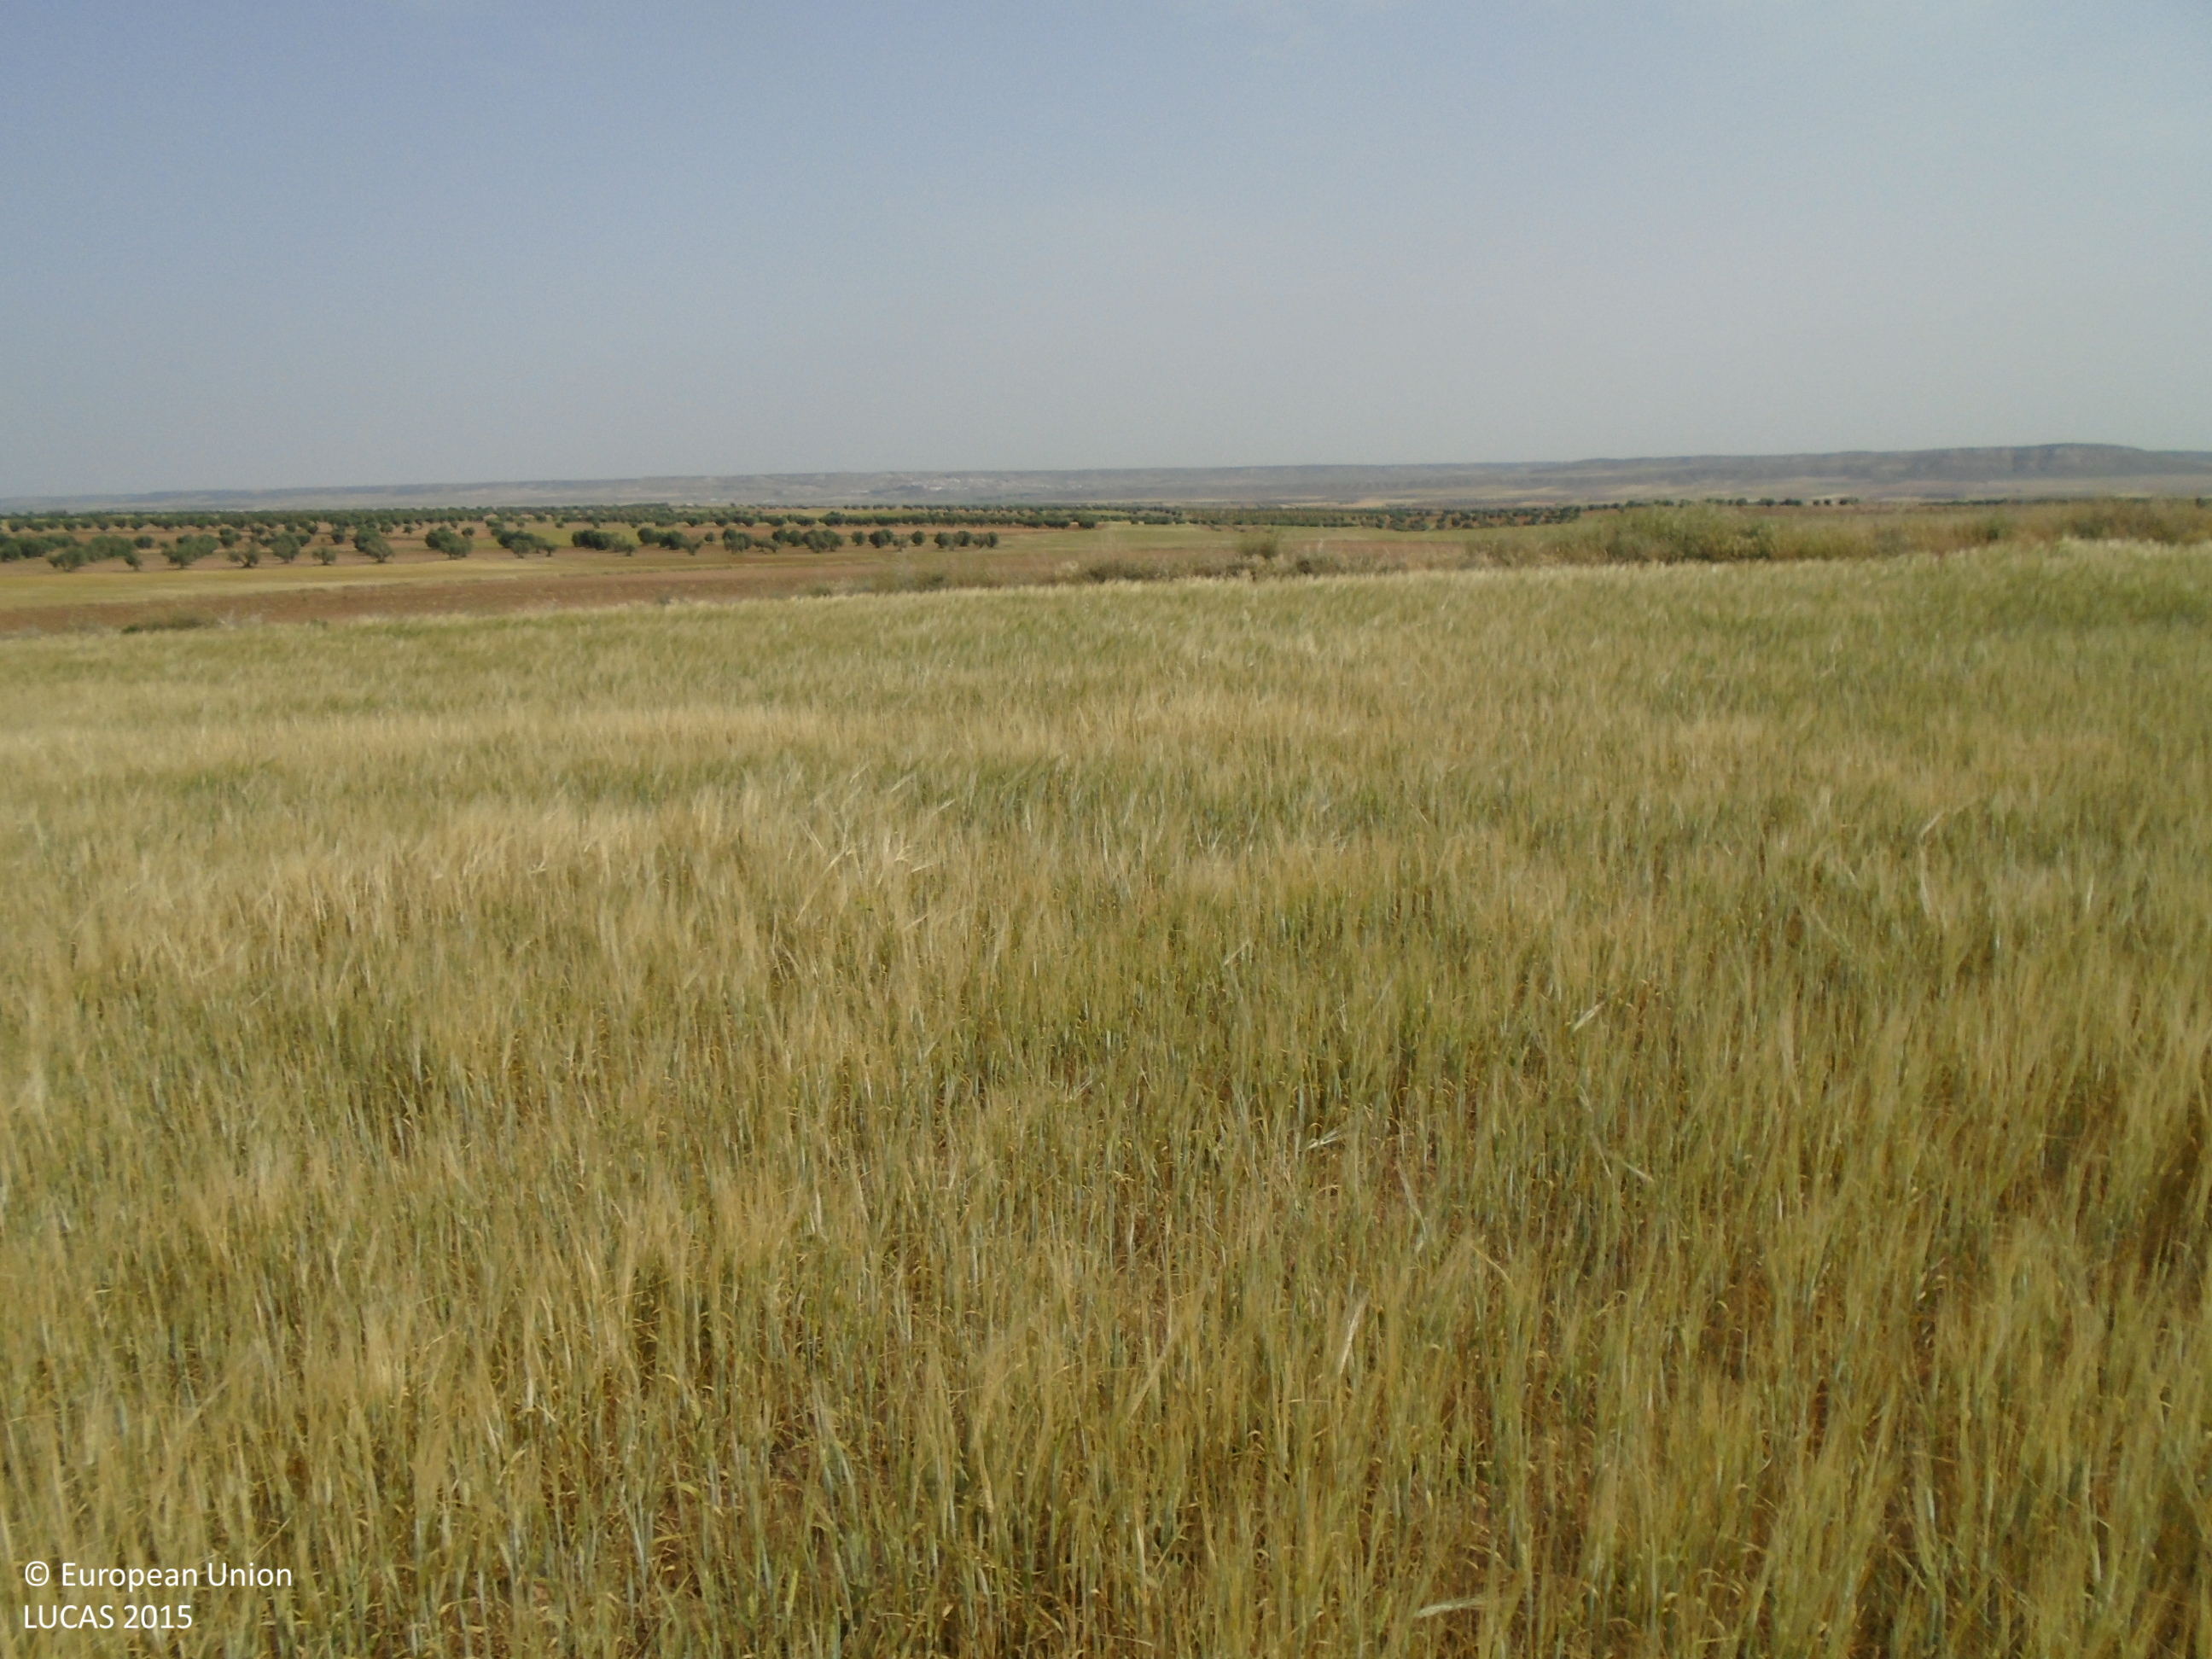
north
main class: Cropland
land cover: Barley
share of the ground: > 75 %
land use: Agriculture (excluding fallow land and kitchen gardens)
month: May
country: ES
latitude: 39.7905
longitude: -3.6091
